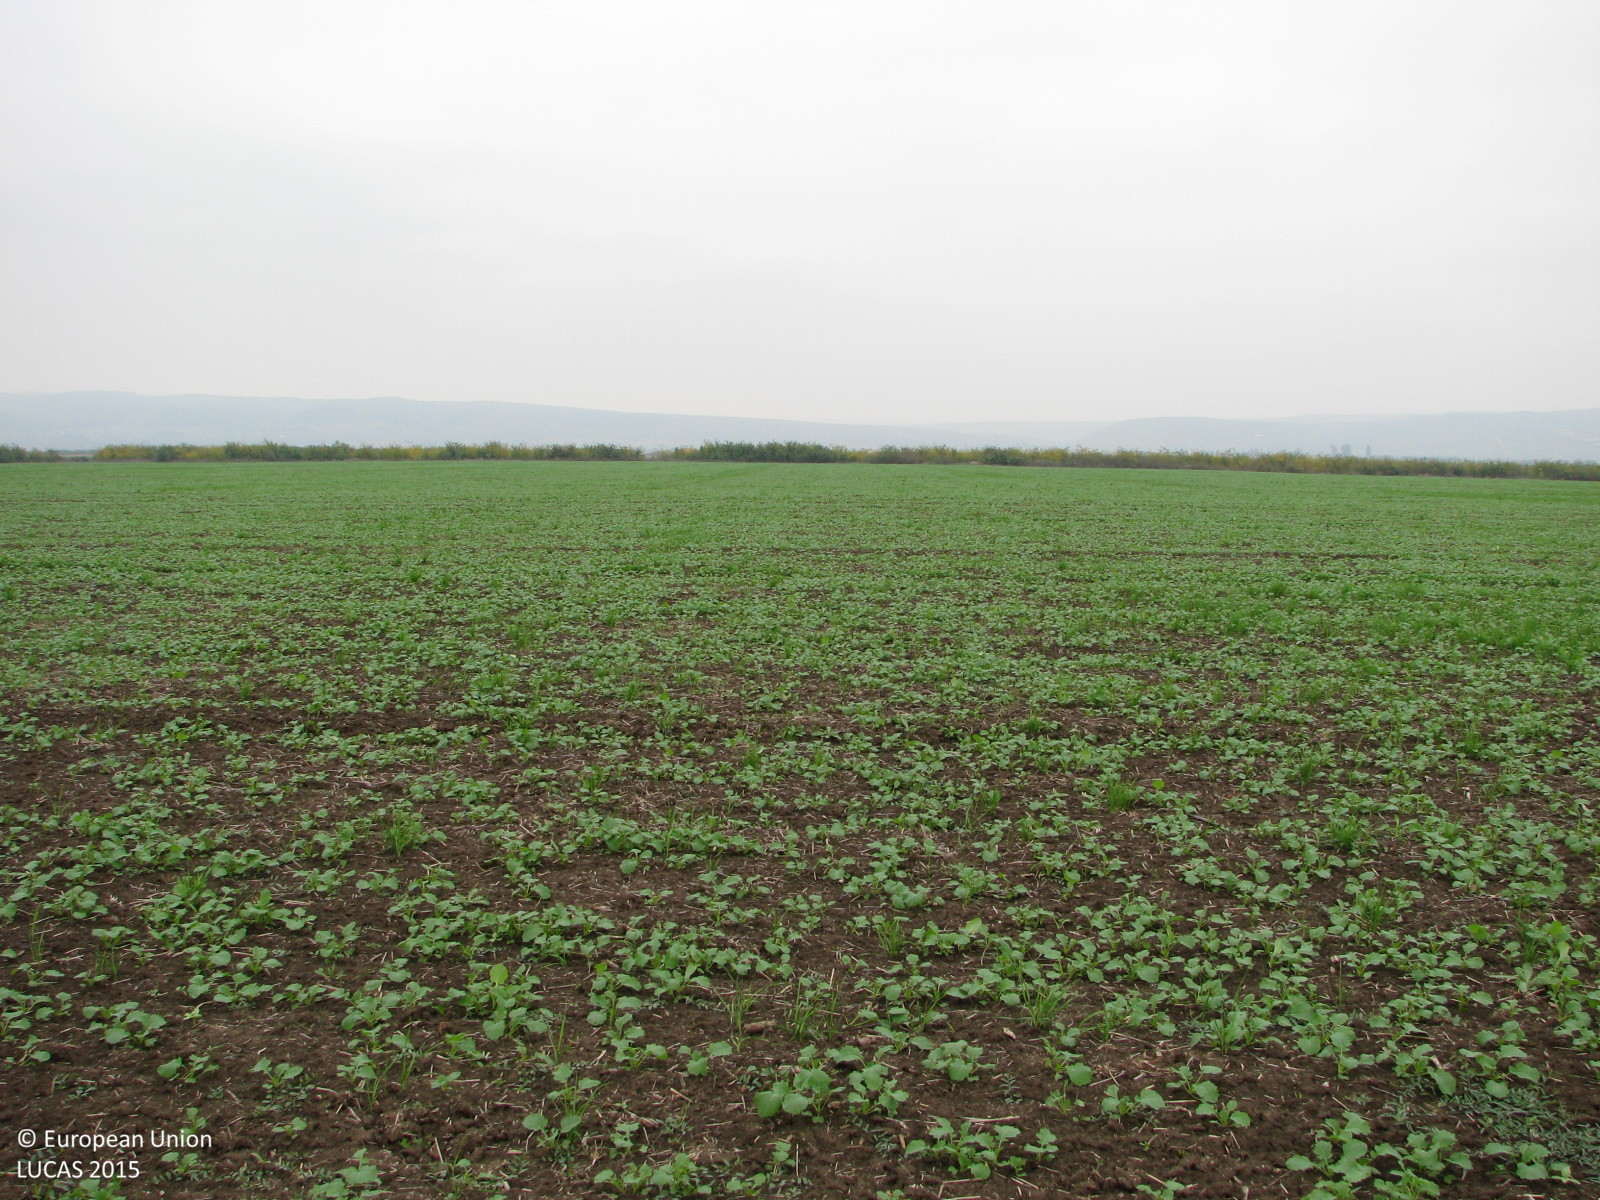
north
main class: Cropland
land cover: Rape and turnip rape
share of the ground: 25 - 50 %
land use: Agriculture (excluding fallow land and kitchen gardens)
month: October
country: BG
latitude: 42.6055
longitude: 26.6625
